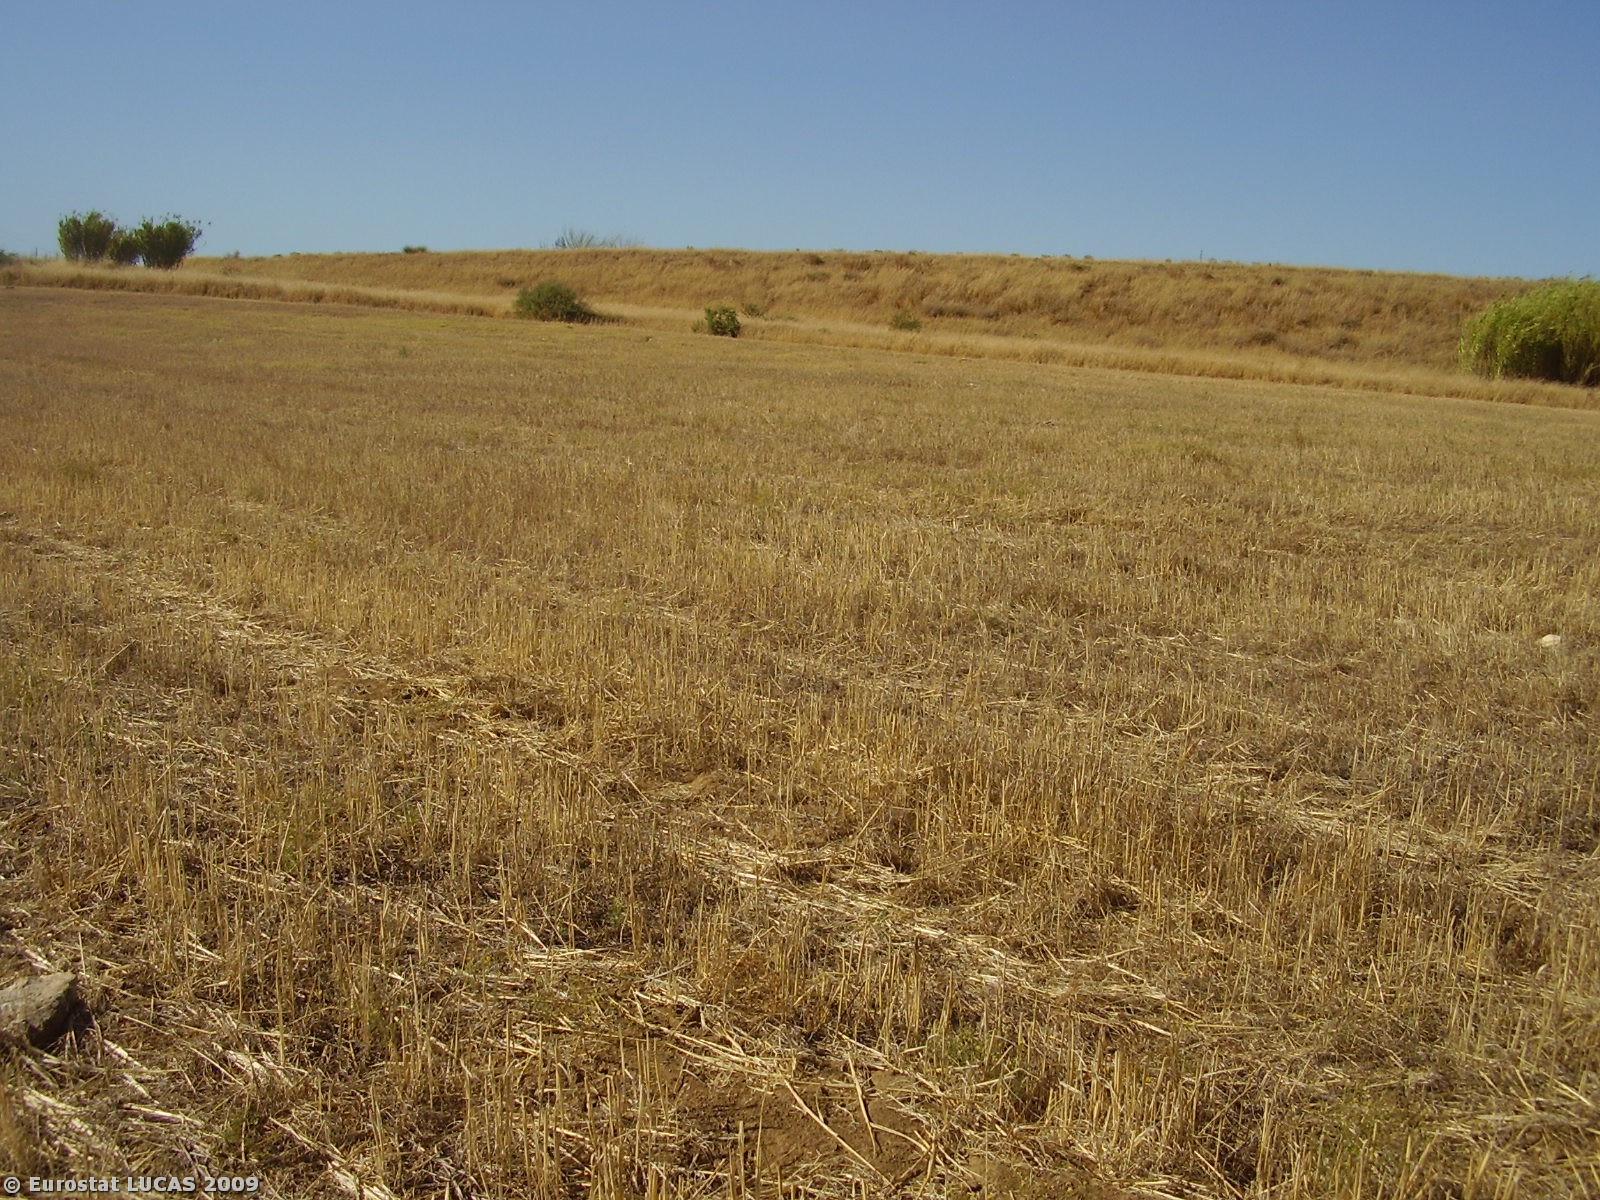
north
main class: Cropland
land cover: Common wheat
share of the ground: < 10 %
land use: Agriculture (excluding fallow land and kitchen gardens)
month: July
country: PT
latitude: 38.0169
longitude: -7.6905
